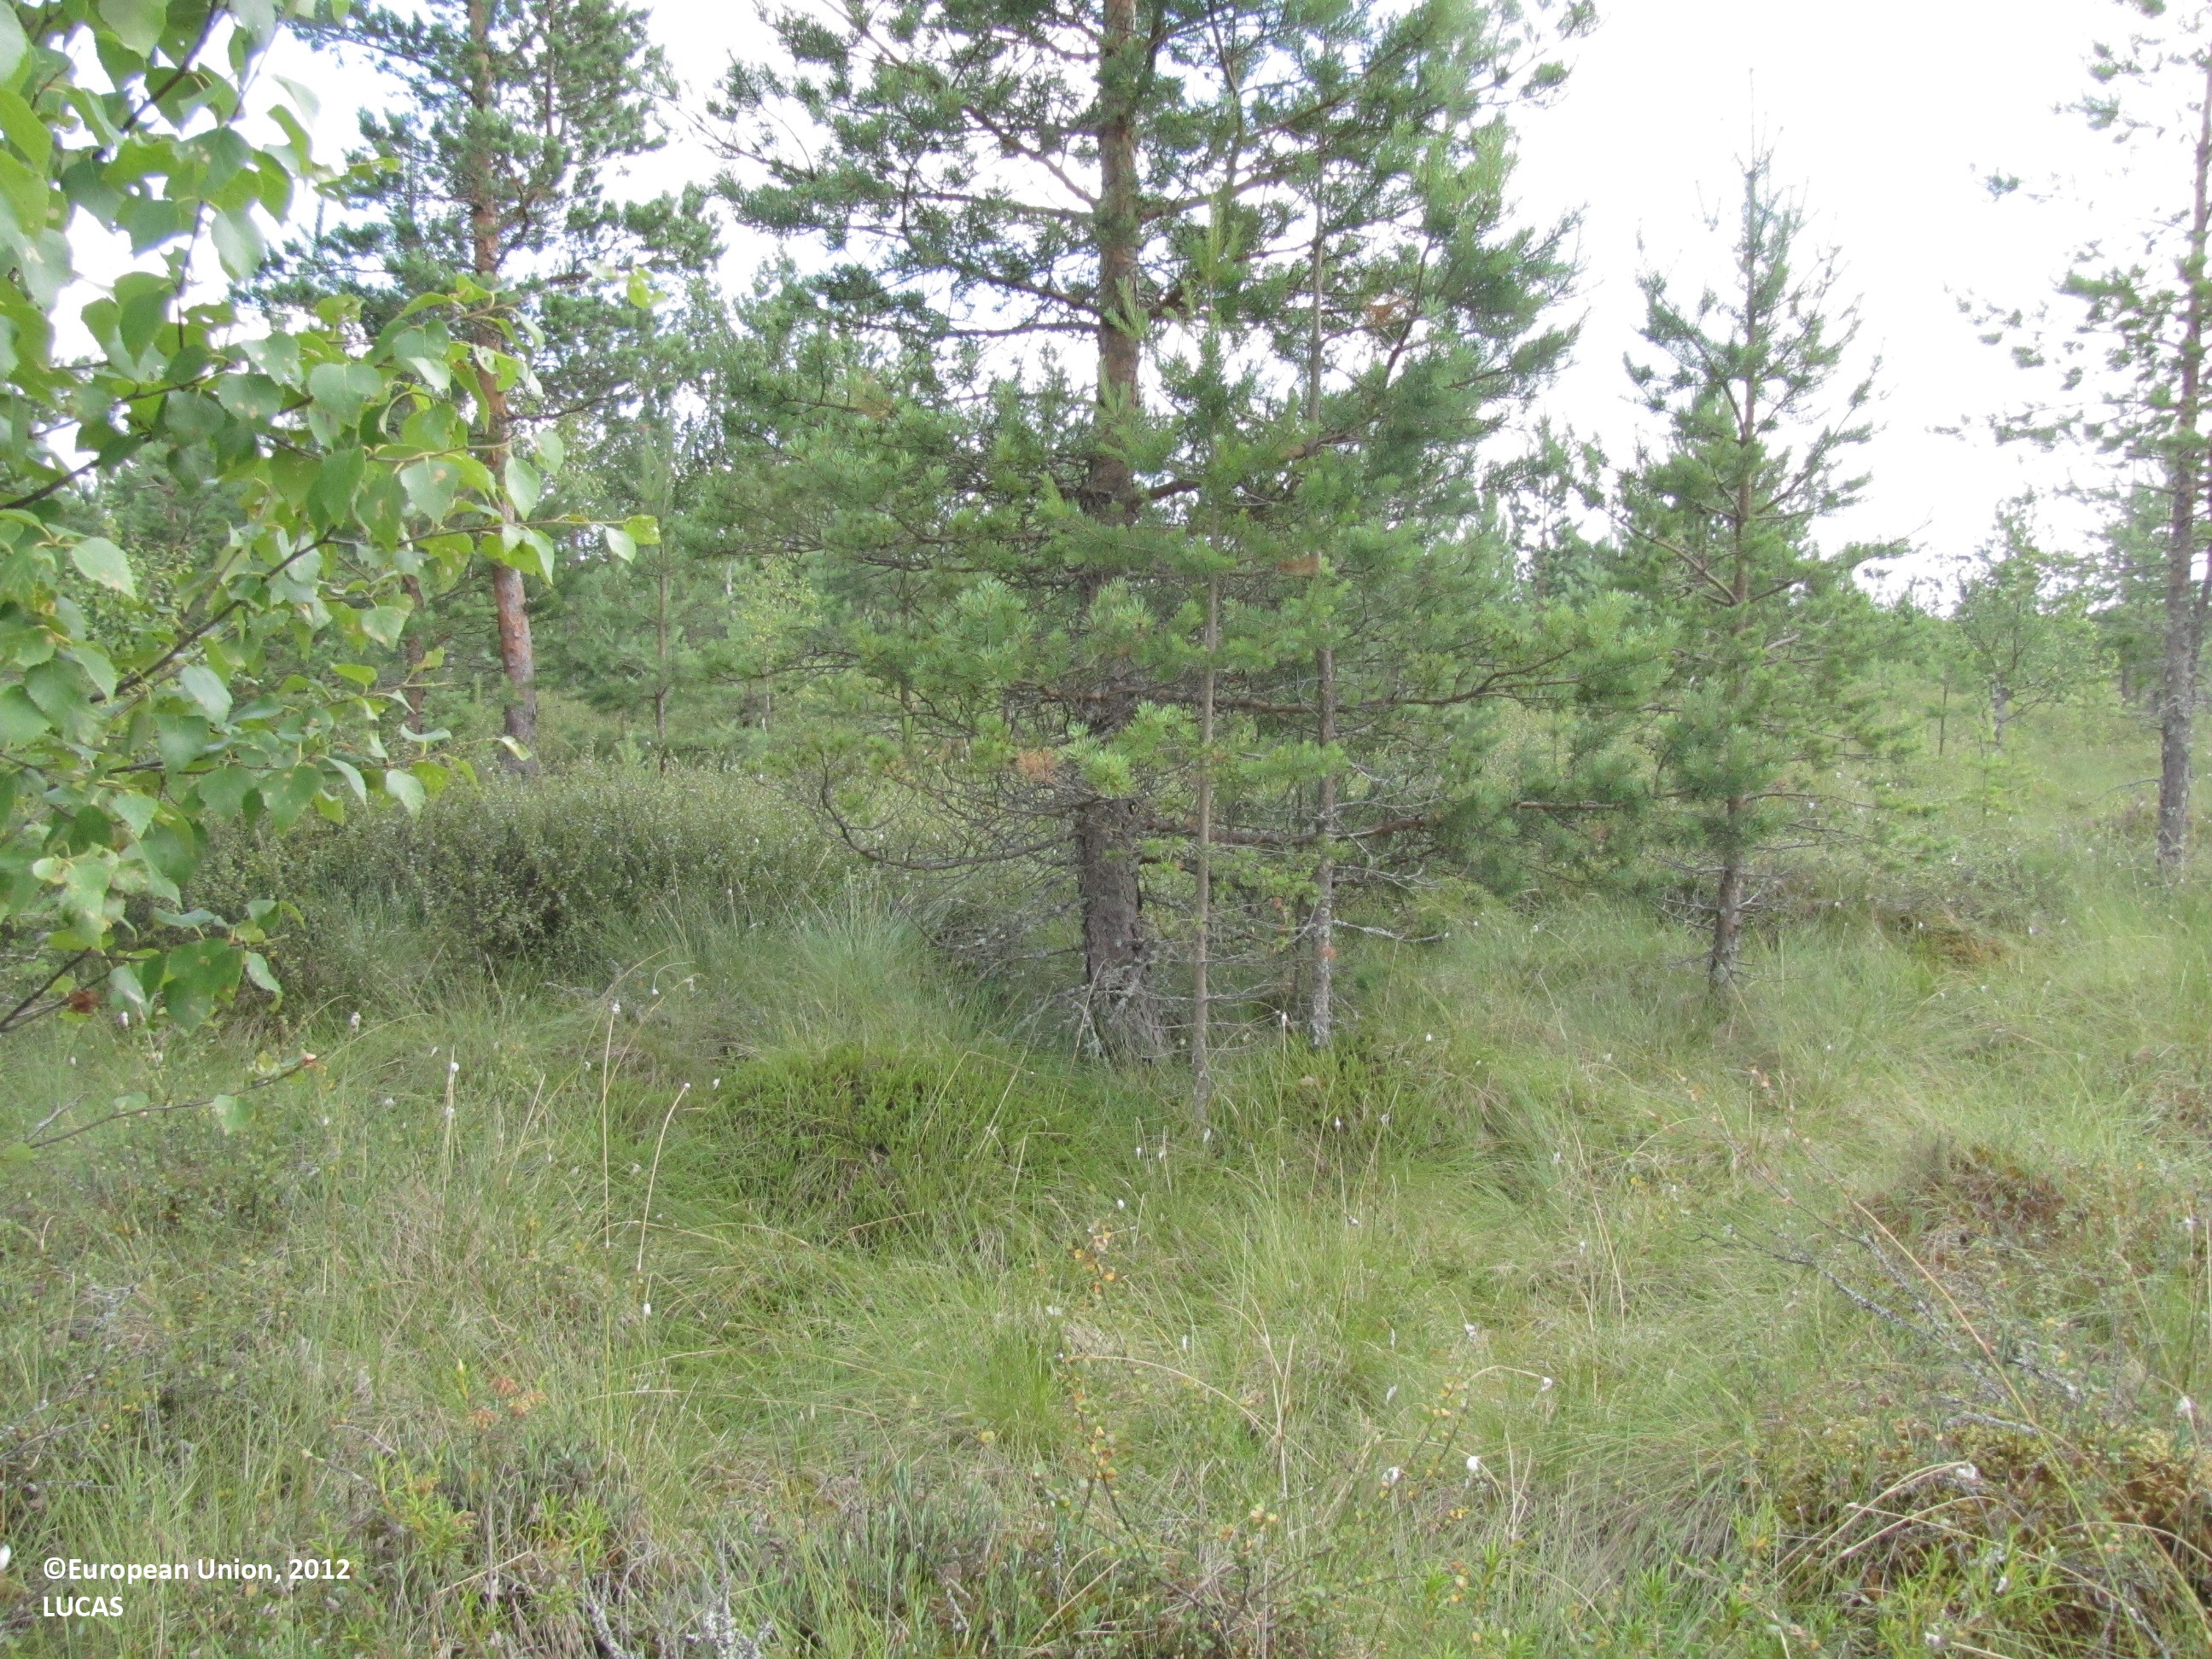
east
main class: Woodland
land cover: Pine dominated coniferous woodland
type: mire and swamp forests
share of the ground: 25 - 50 %
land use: Forestry
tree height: < 5 m
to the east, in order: Pine dominated coniferous woodland; Ditches and canals; Pine dominated coniferous woodland; Ditches and canals; Pine dominated coniferous woodland; Ditches and canals; Pine dominated coniferous woodland; Ditches and canals; Pine dominated coniferous woodland; Ditches and canals; Pine dominated coniferous woodland
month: July
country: FI
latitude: 62.2750
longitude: 23.3067
